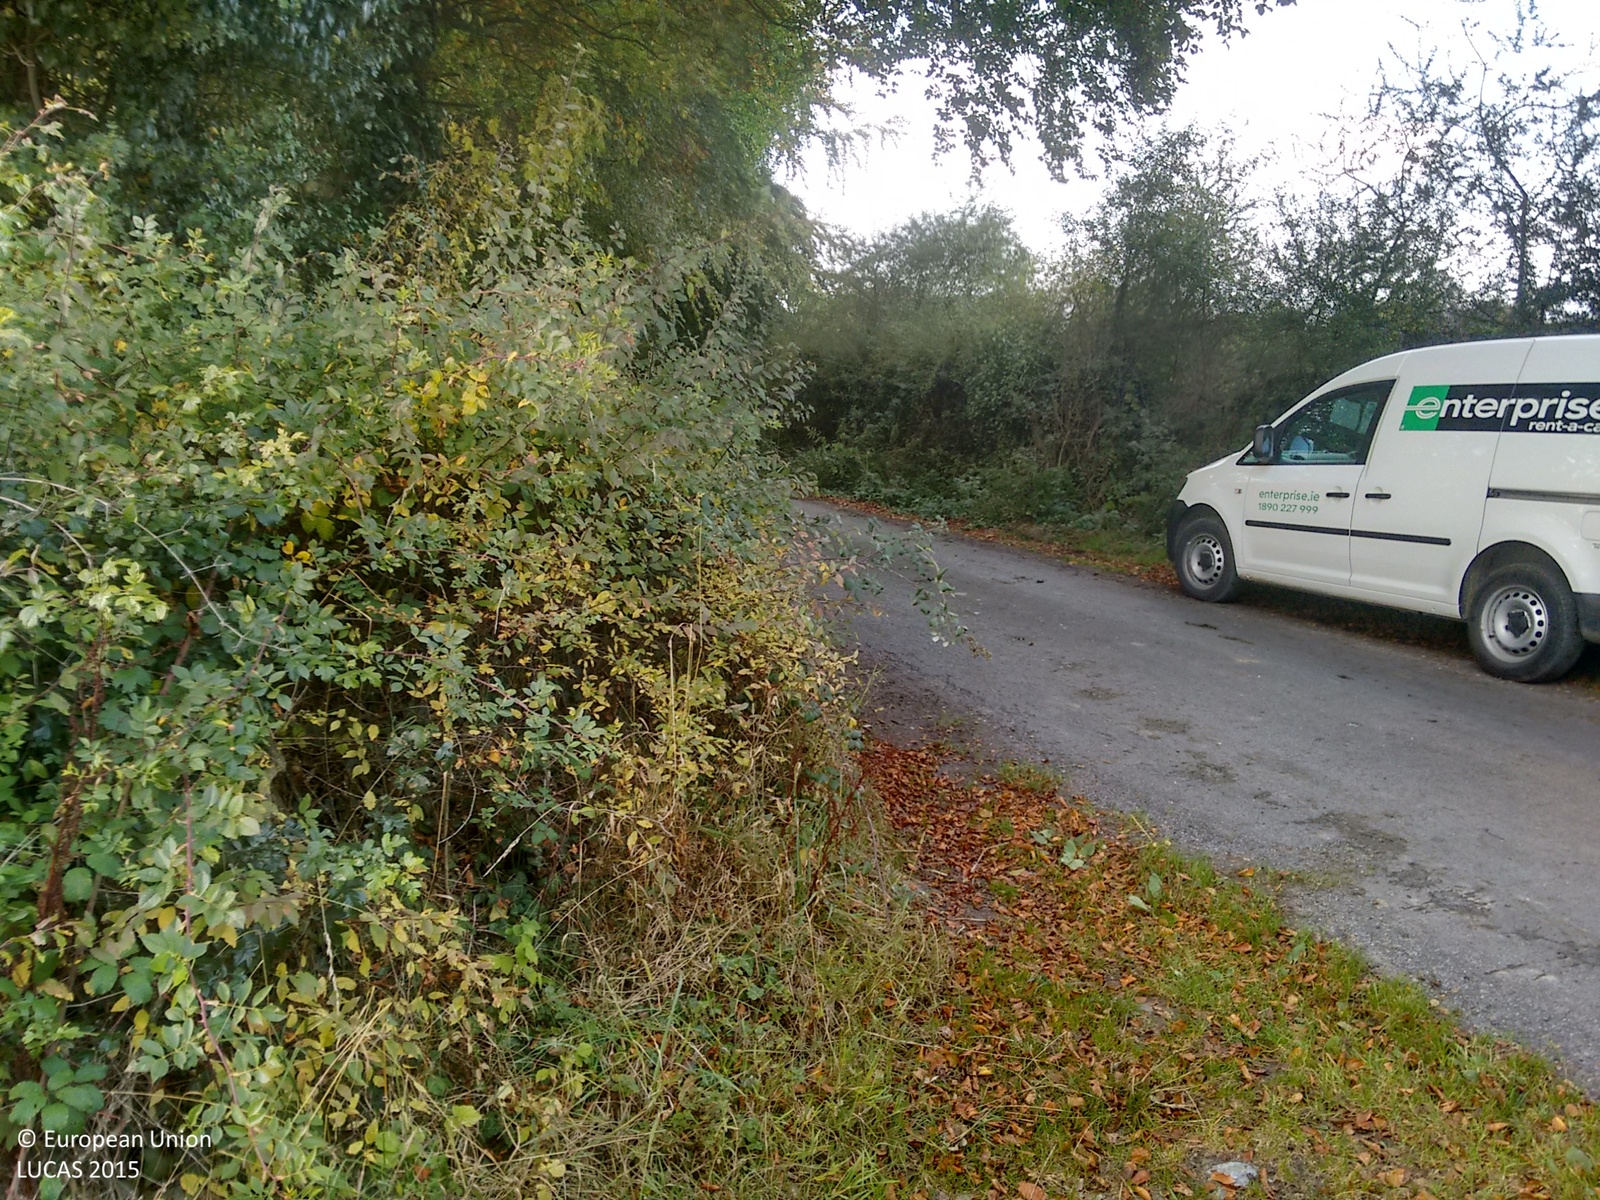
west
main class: Grassland
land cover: Grassland without tree/shrub cover
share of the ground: > 75 %
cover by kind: herbaceous plants 100 %
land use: Agriculture (excluding fallow land and kitchen gardens)
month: October
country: IE
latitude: 52.8343
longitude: -7.6036
